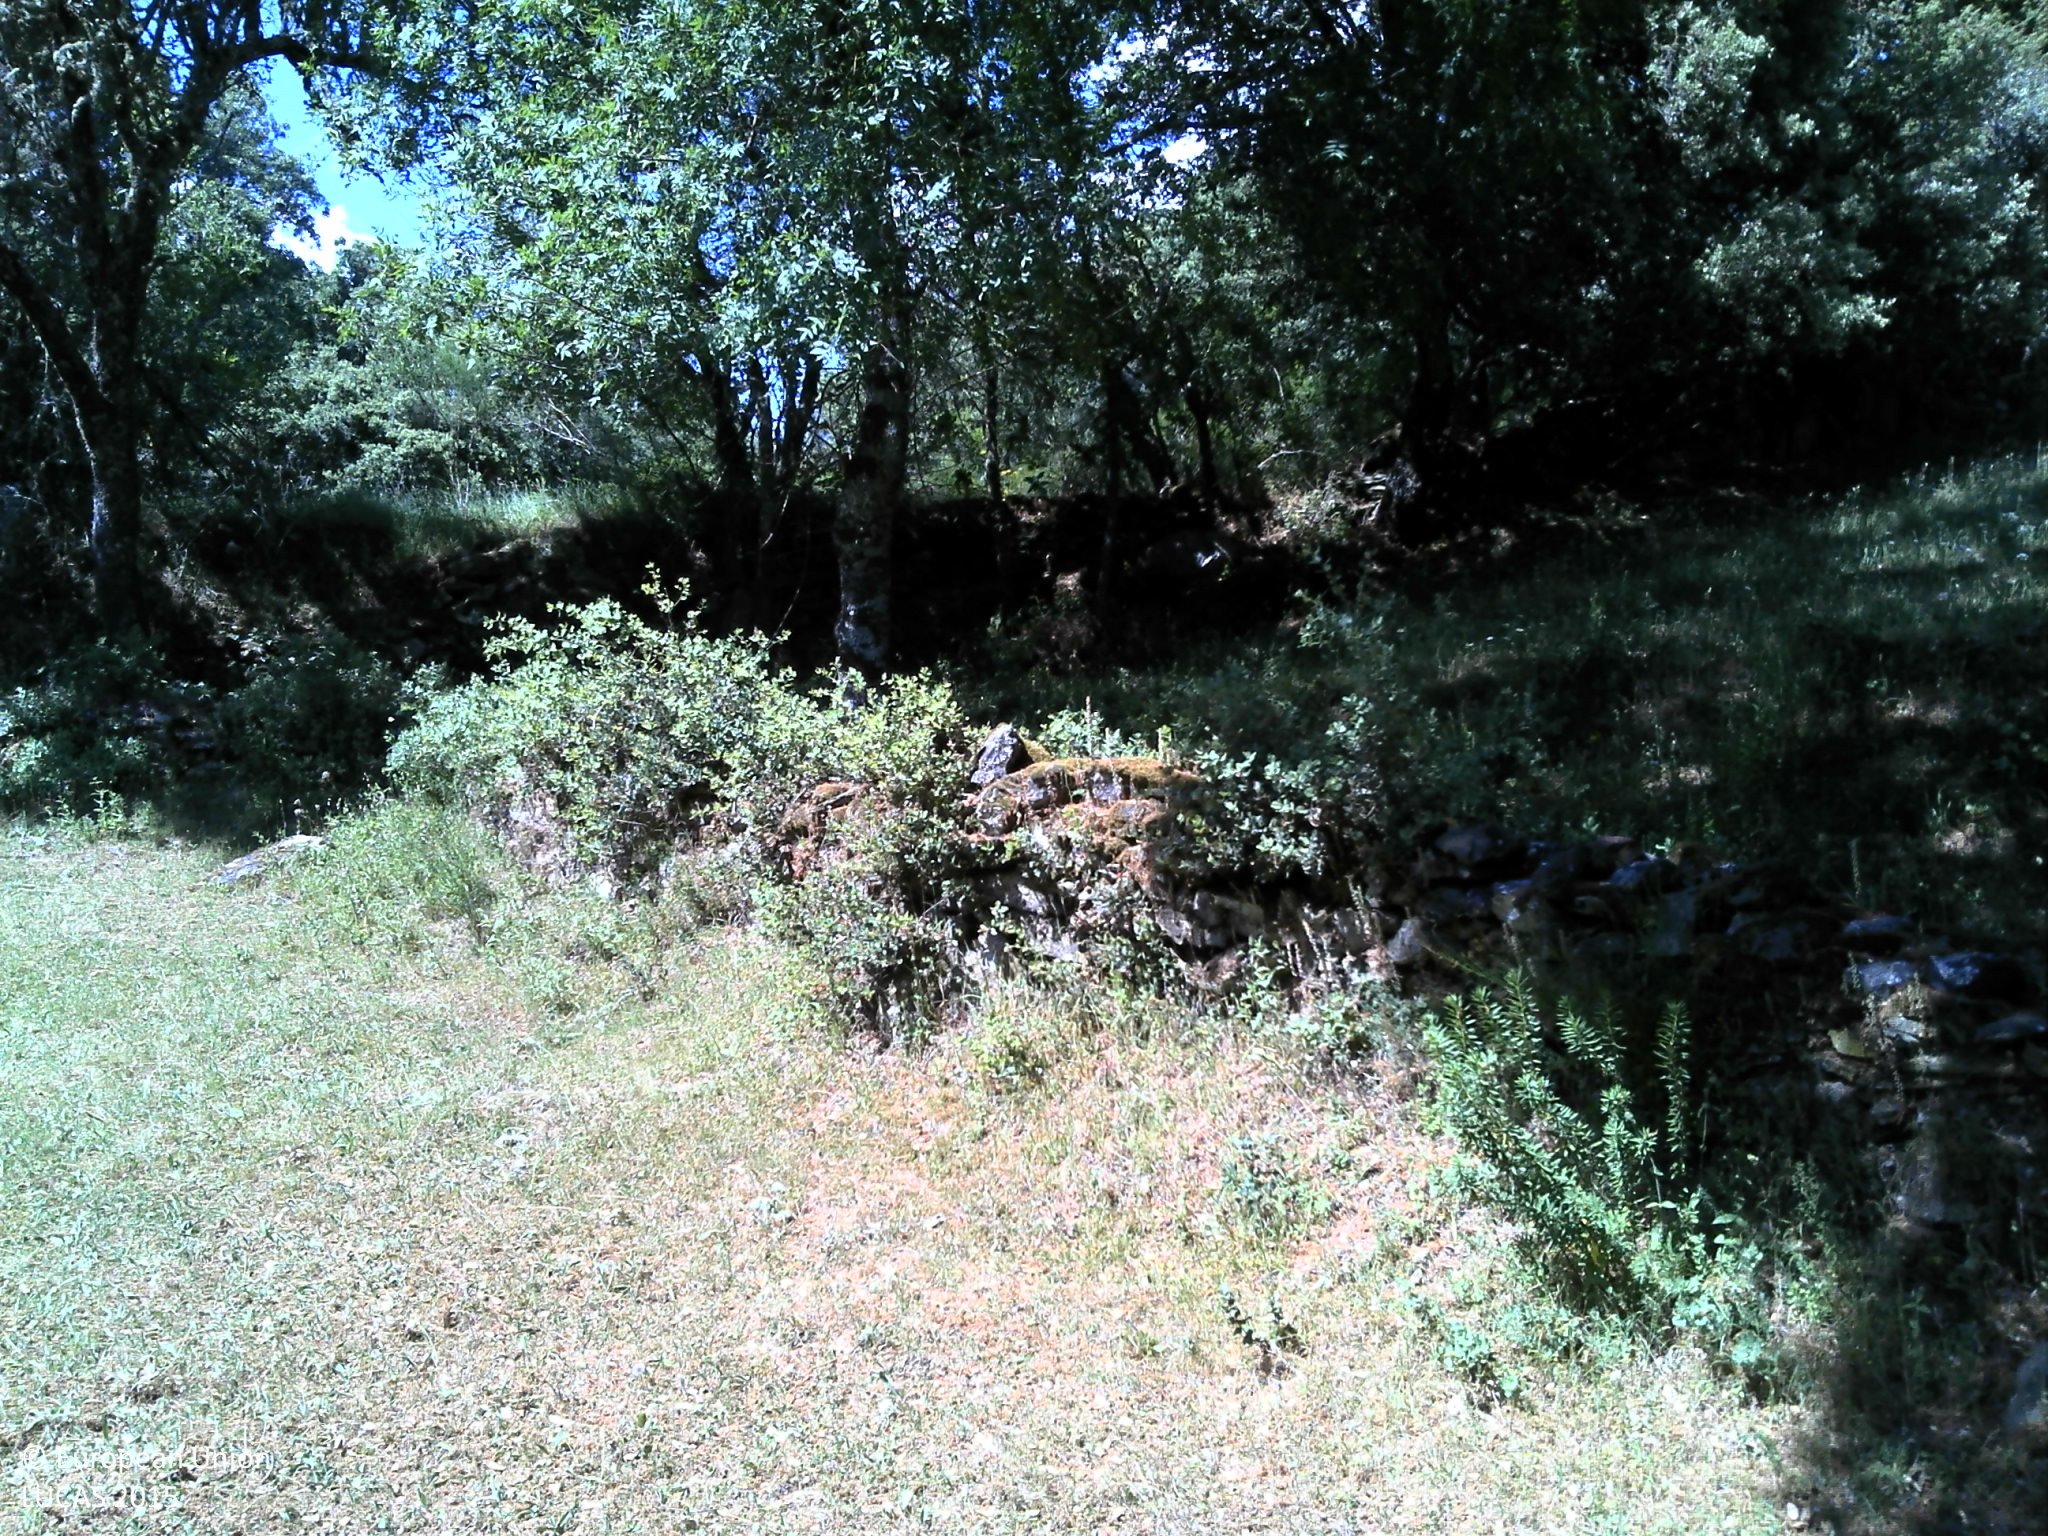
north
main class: Woodland
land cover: Broadleaved woodland
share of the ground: 50 - 75 %
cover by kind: broadleaved forest trees 60 %, herbaceous plants 30 %, unconsolidated bare surface 10 %
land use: Forestry
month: May
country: PT
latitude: 41.5779
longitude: -6.2050
